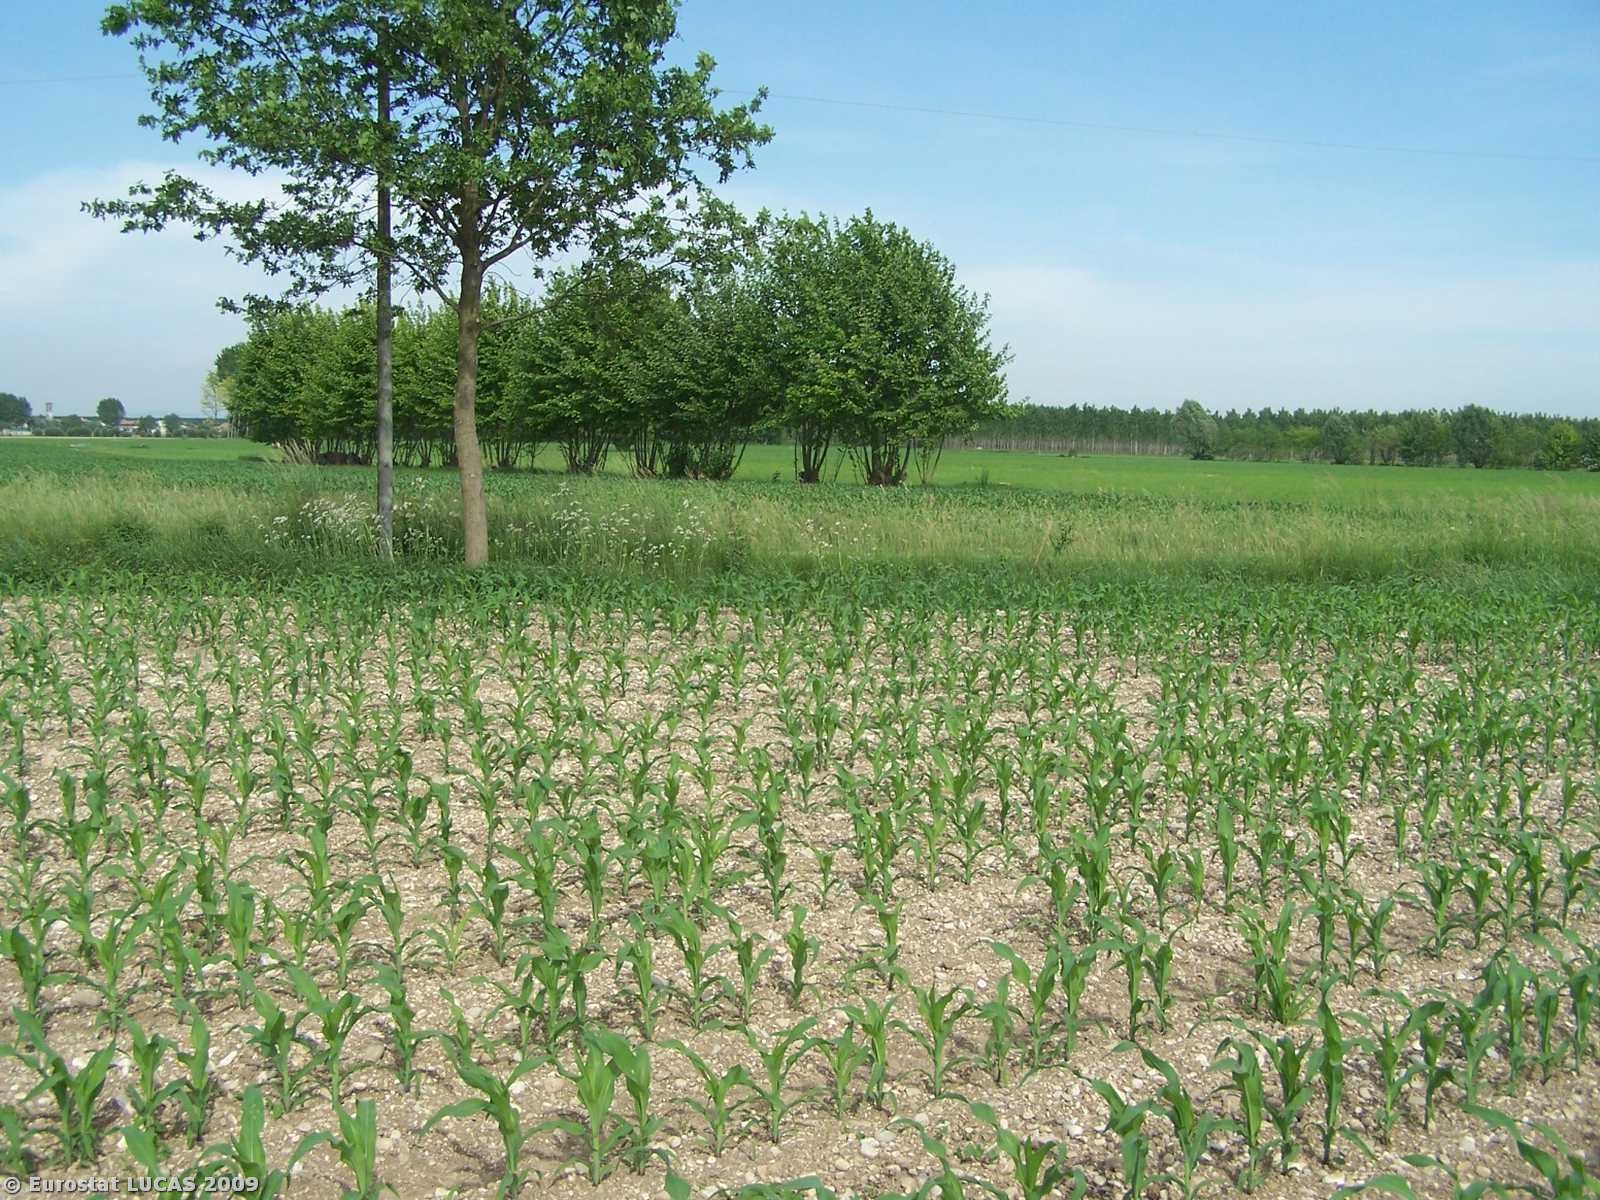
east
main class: Cropland
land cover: Maize
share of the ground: 25 - 50 %
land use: Agriculture (excluding fallow land and kitchen gardens)
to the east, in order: Maize; Grass margins; Ditches and canals; Grass margins; Paved roads, cycling and walking lanes; Grass margins; Ditches and canals; Grass margins; Maize; Paved roads, cycling and walking lanes; Grass margins; Managed hedges; Lucerne; Maize
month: May
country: IT
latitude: 45.9133
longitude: 12.9745
